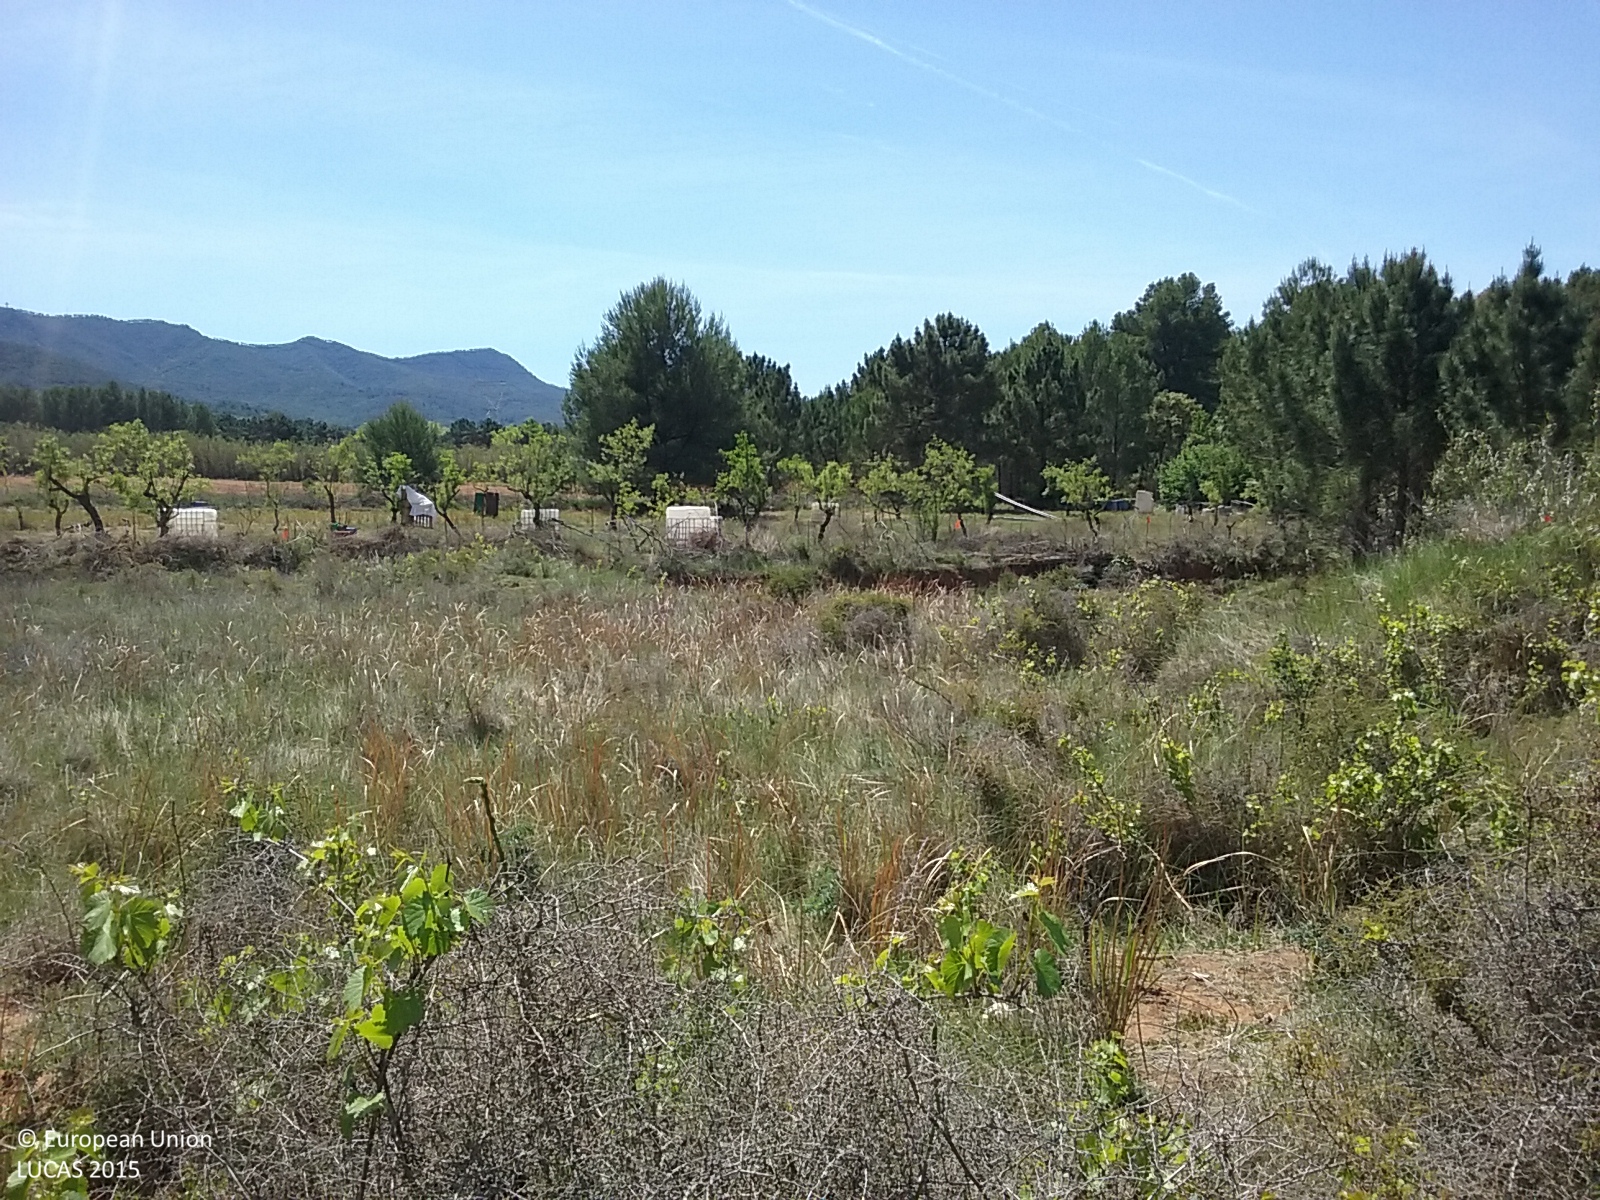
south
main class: Shrubland
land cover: Shrubland with sparse tree cover
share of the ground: > 75 %
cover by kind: herbaceous plants 75 %, shrubs 20 %, broadleaved forest trees 5 %
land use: Abandoned areas
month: May
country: ES
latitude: 40.1208
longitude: 0.0123
